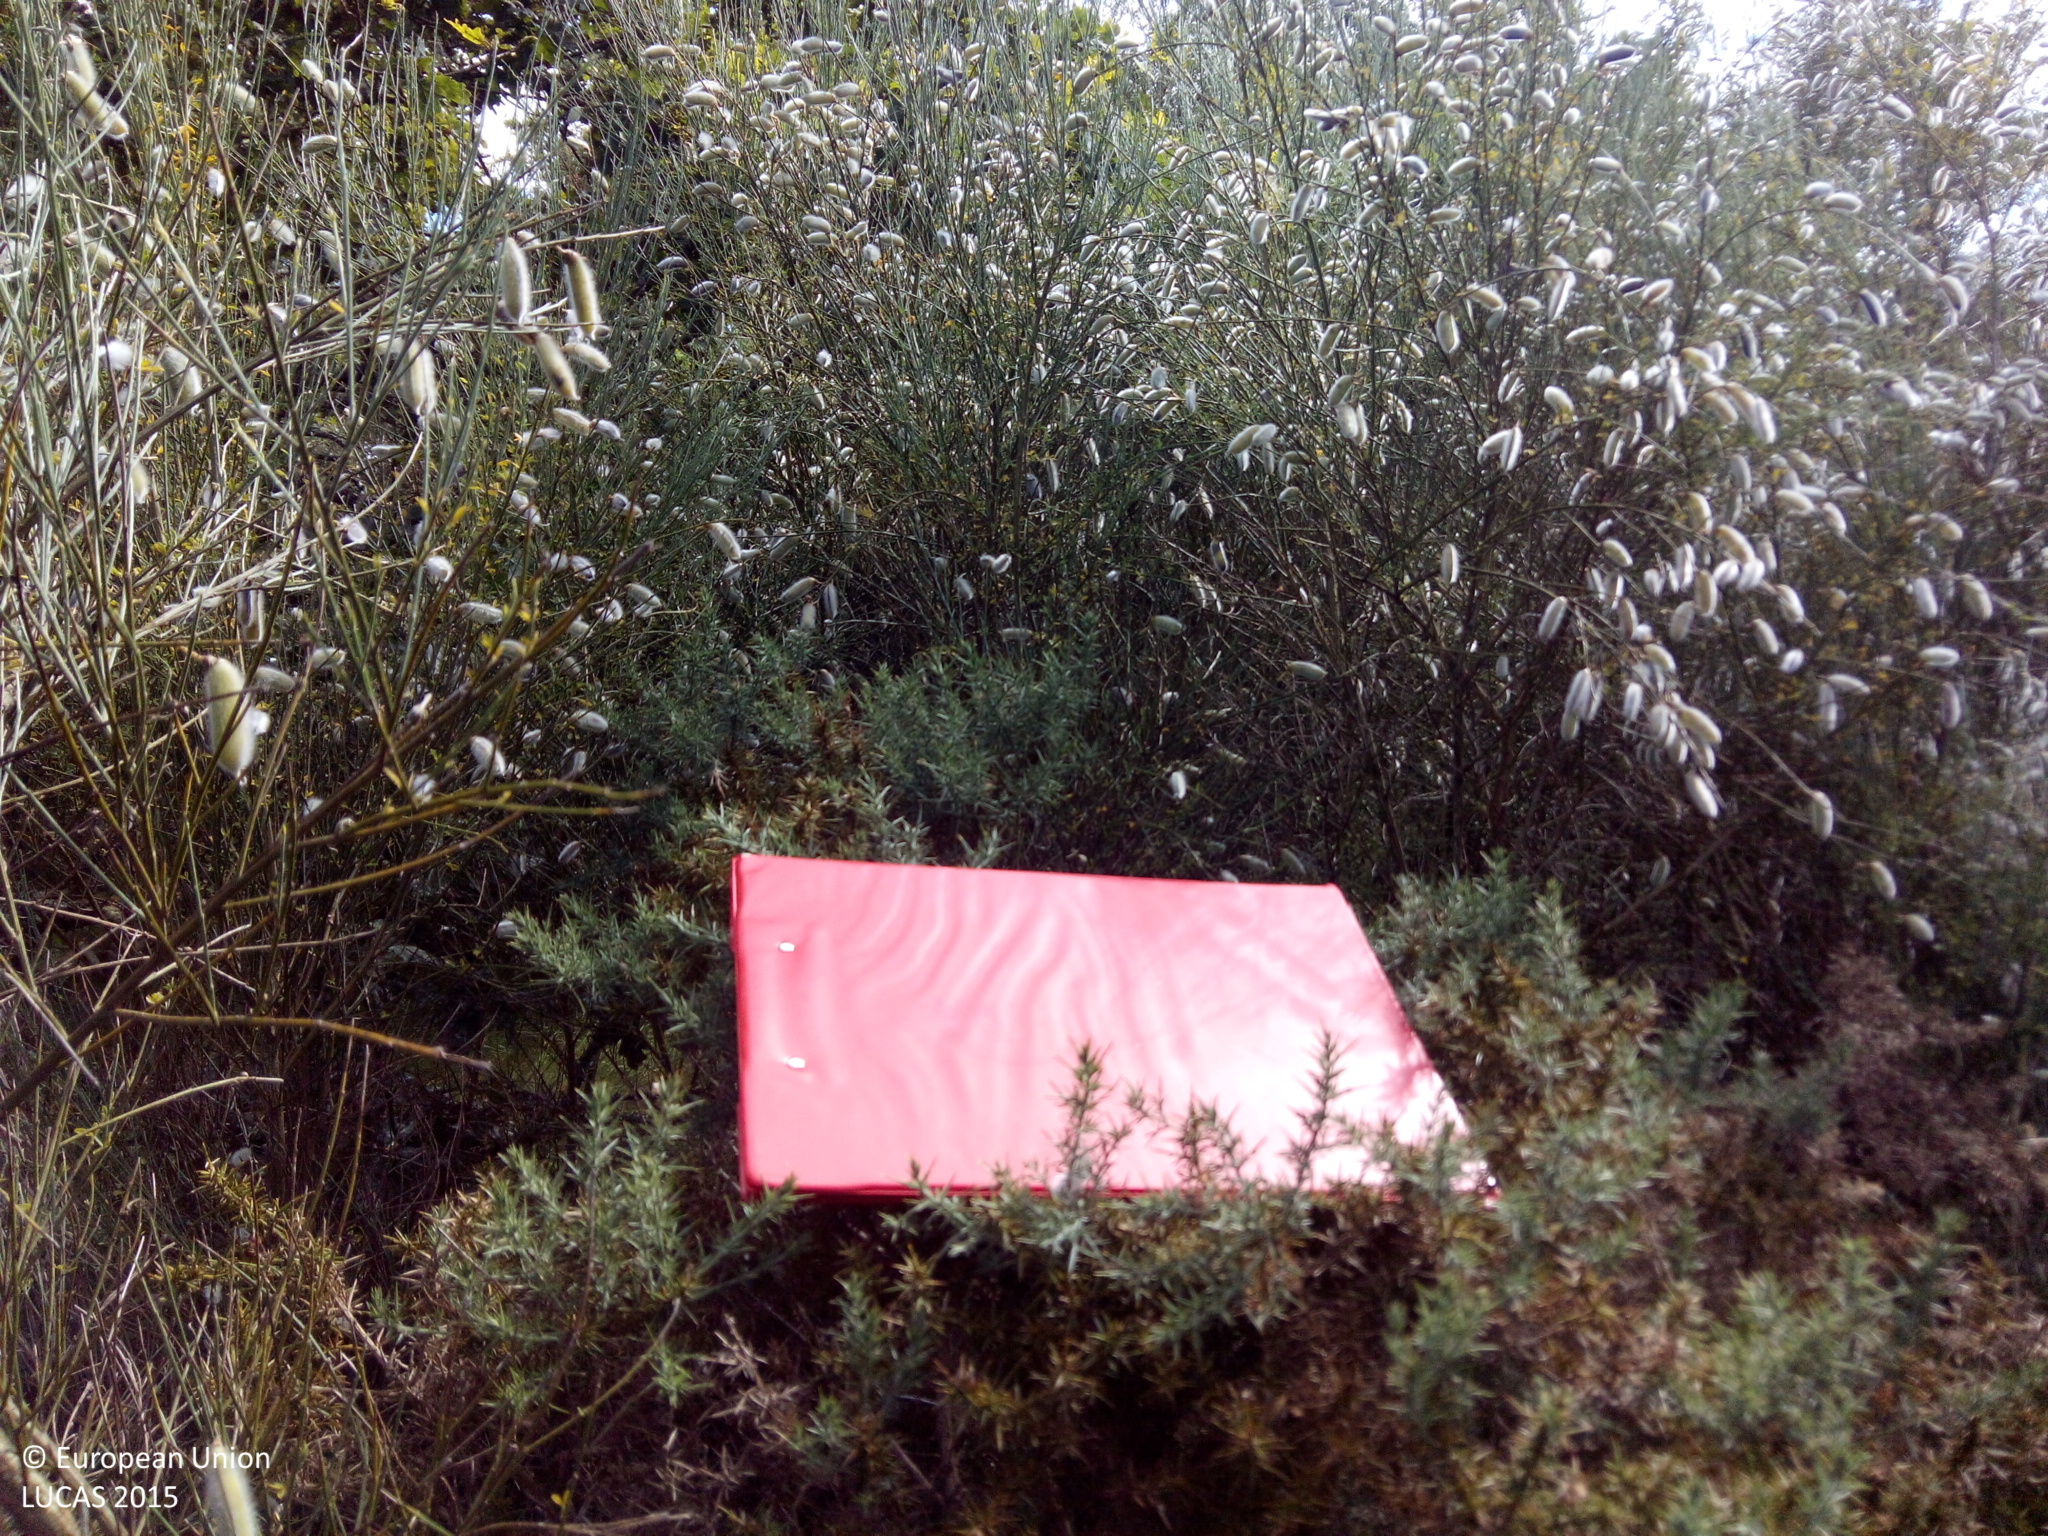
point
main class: Woodland
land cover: Other mixed woodland
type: acidophilous oak and oak-birch forest
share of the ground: > 75 %
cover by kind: shrubs 75 %, broadleaved forest trees 15 %, coniferous forest trees 10 %
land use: Abandoned areas
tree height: > 5 m
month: July
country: ES
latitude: 42.3615
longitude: -8.2653
